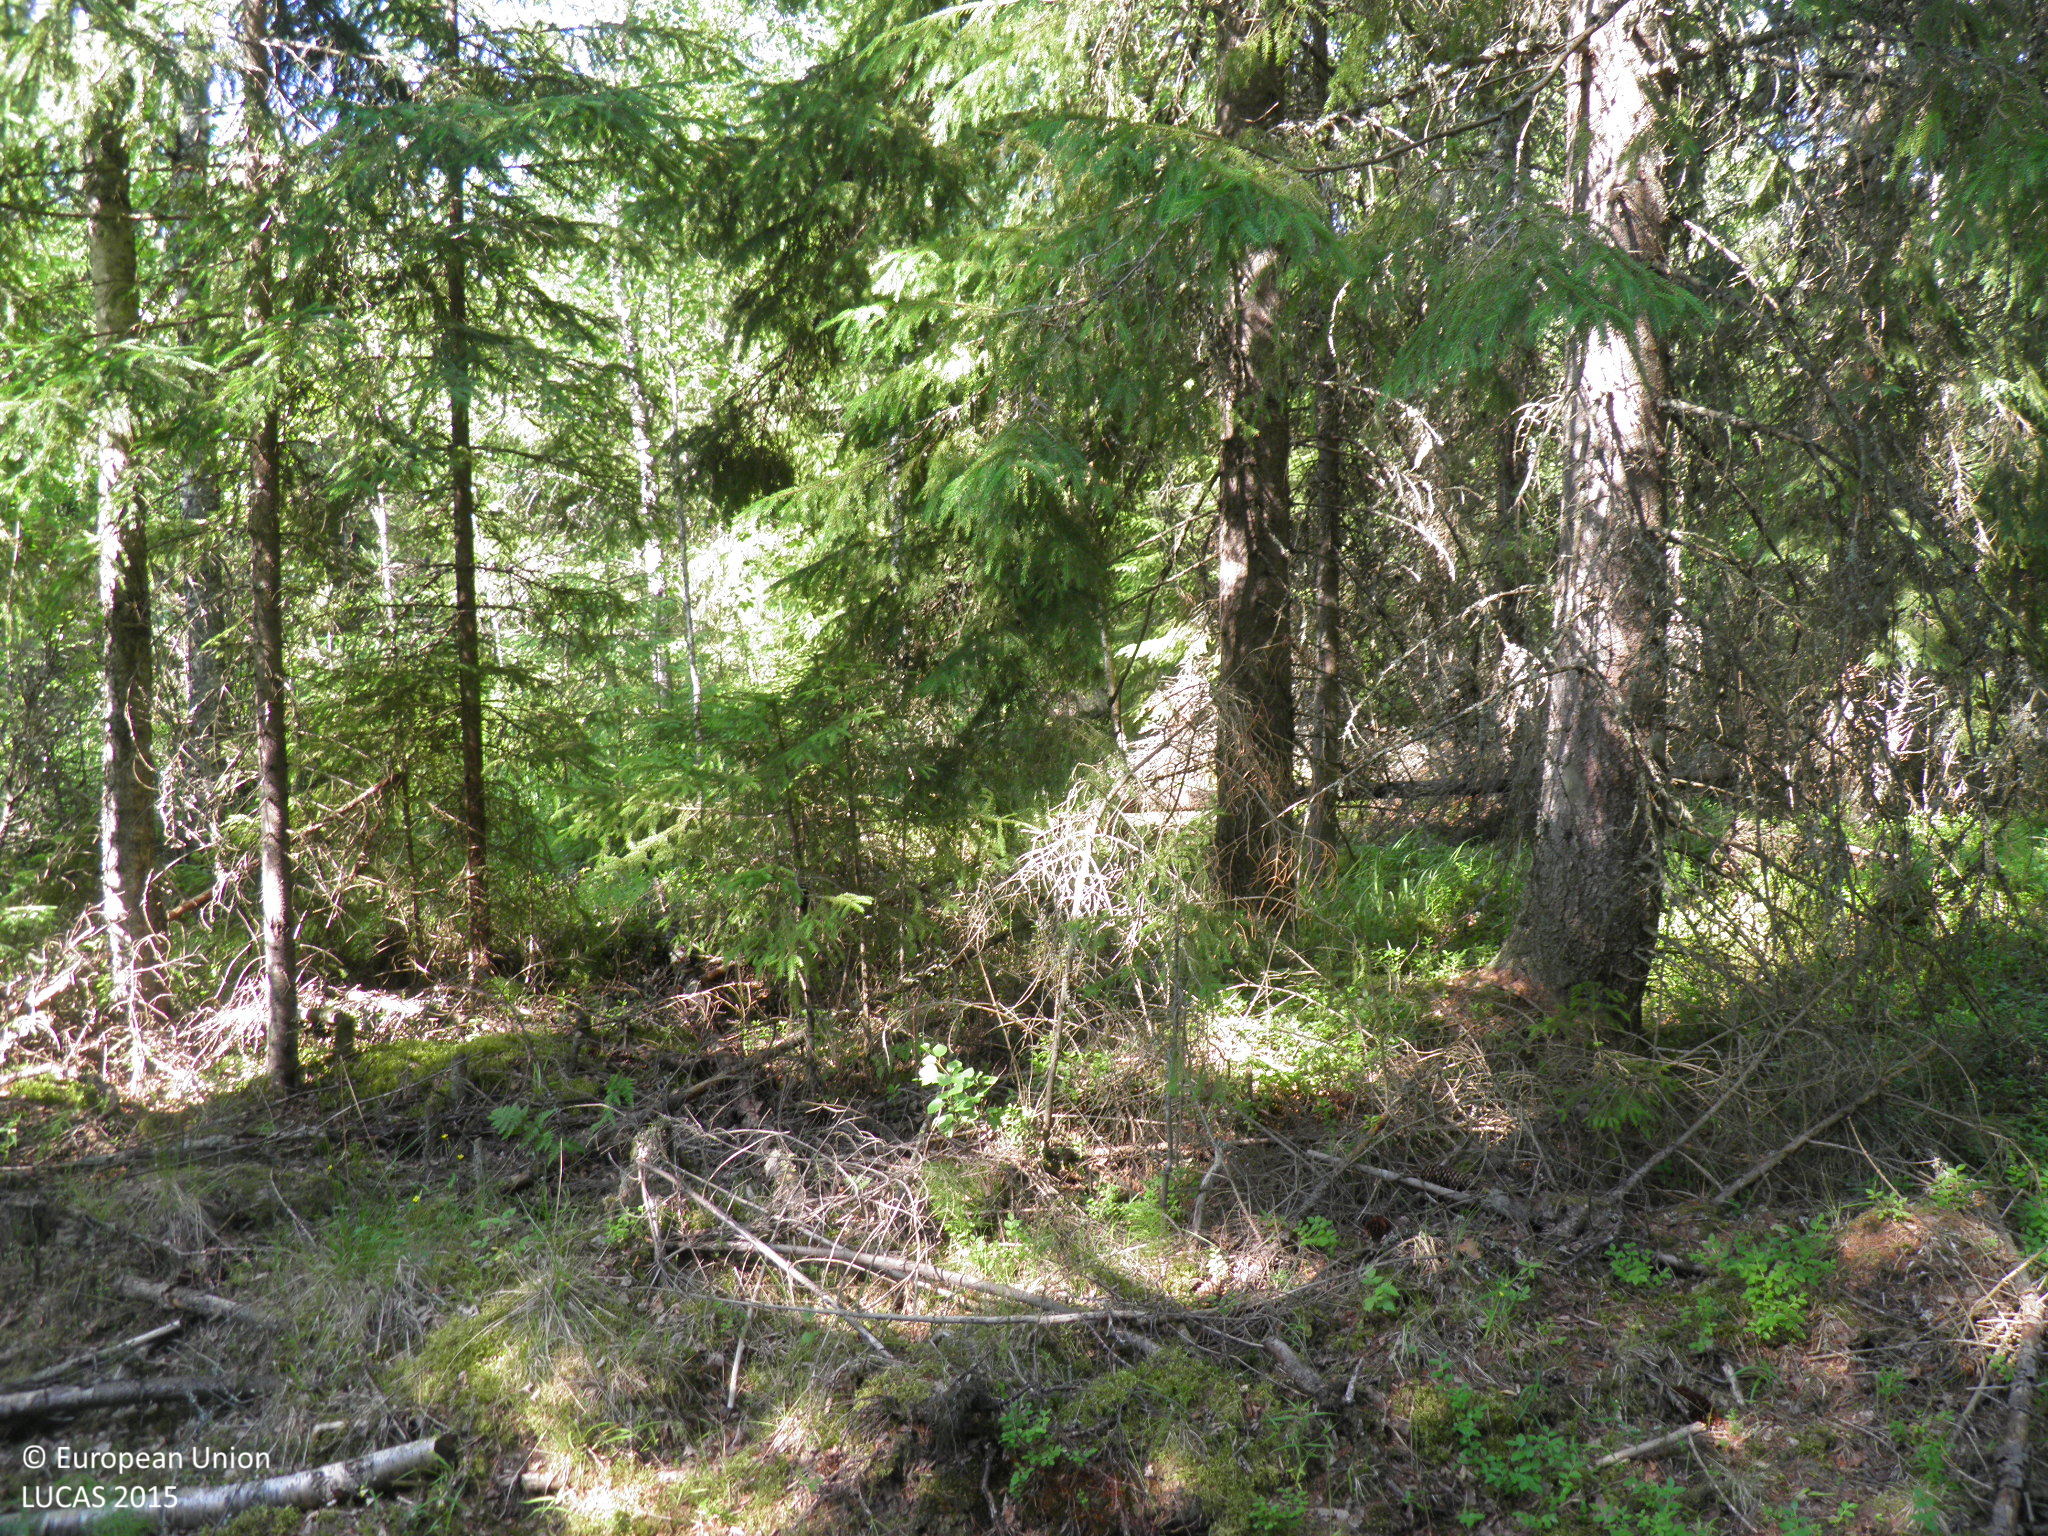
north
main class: Woodland
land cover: Spruce dominated mixed woodland
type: hemiboreal forest and nemoral coniferous forest and mixed broadleaved-coniferous forest
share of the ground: 50 - 75 %
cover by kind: coniferous forest trees 40 %, broadleaved forest trees 30 %, shrubs 10 %, herbaceous plants 10 %, lichens and mosses 10 %
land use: Forestry
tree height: > 5 m
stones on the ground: < 10 %
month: July
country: FI
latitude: 60.6250
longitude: 22.9239
